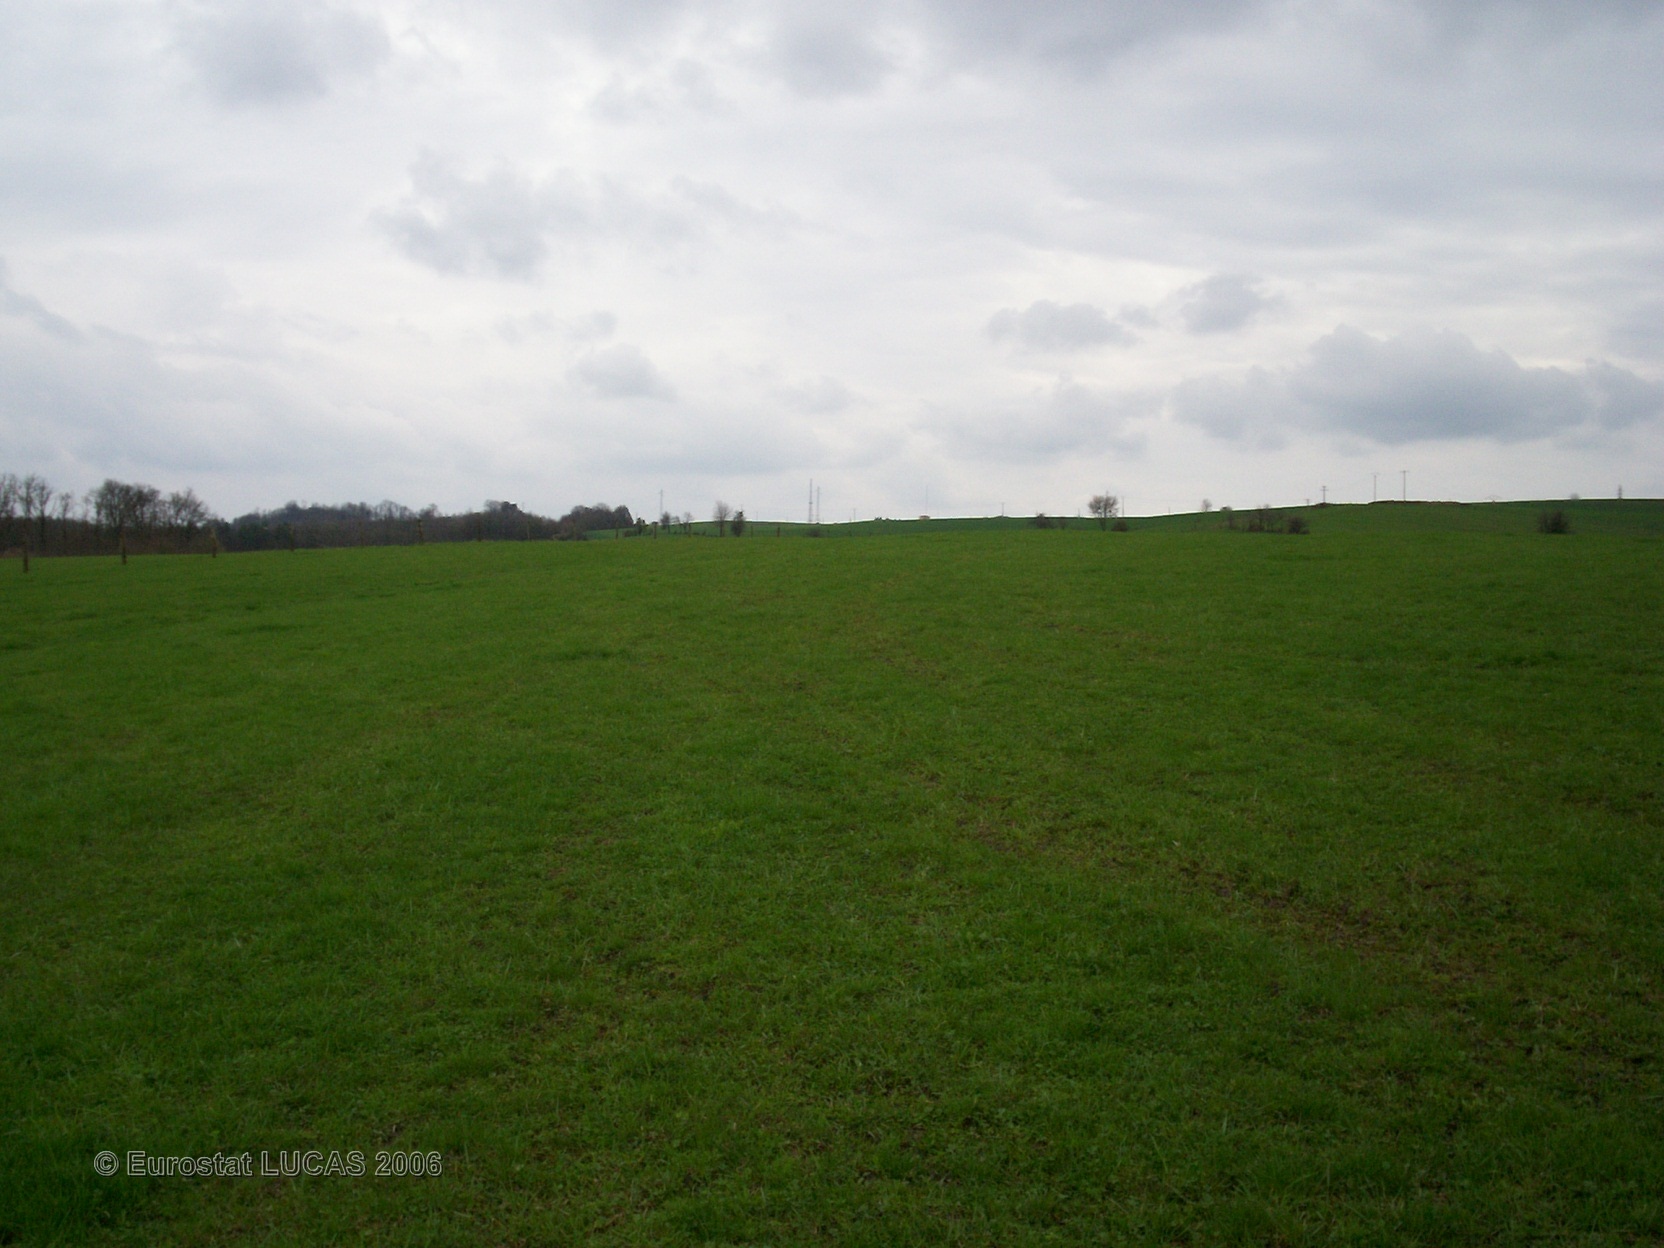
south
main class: Grassland
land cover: Grassland without tree/shrub cover
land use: Agriculture (excluding fallow land and kitchen gardens)
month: April
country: FR
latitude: 48.2411
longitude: 6.0011
